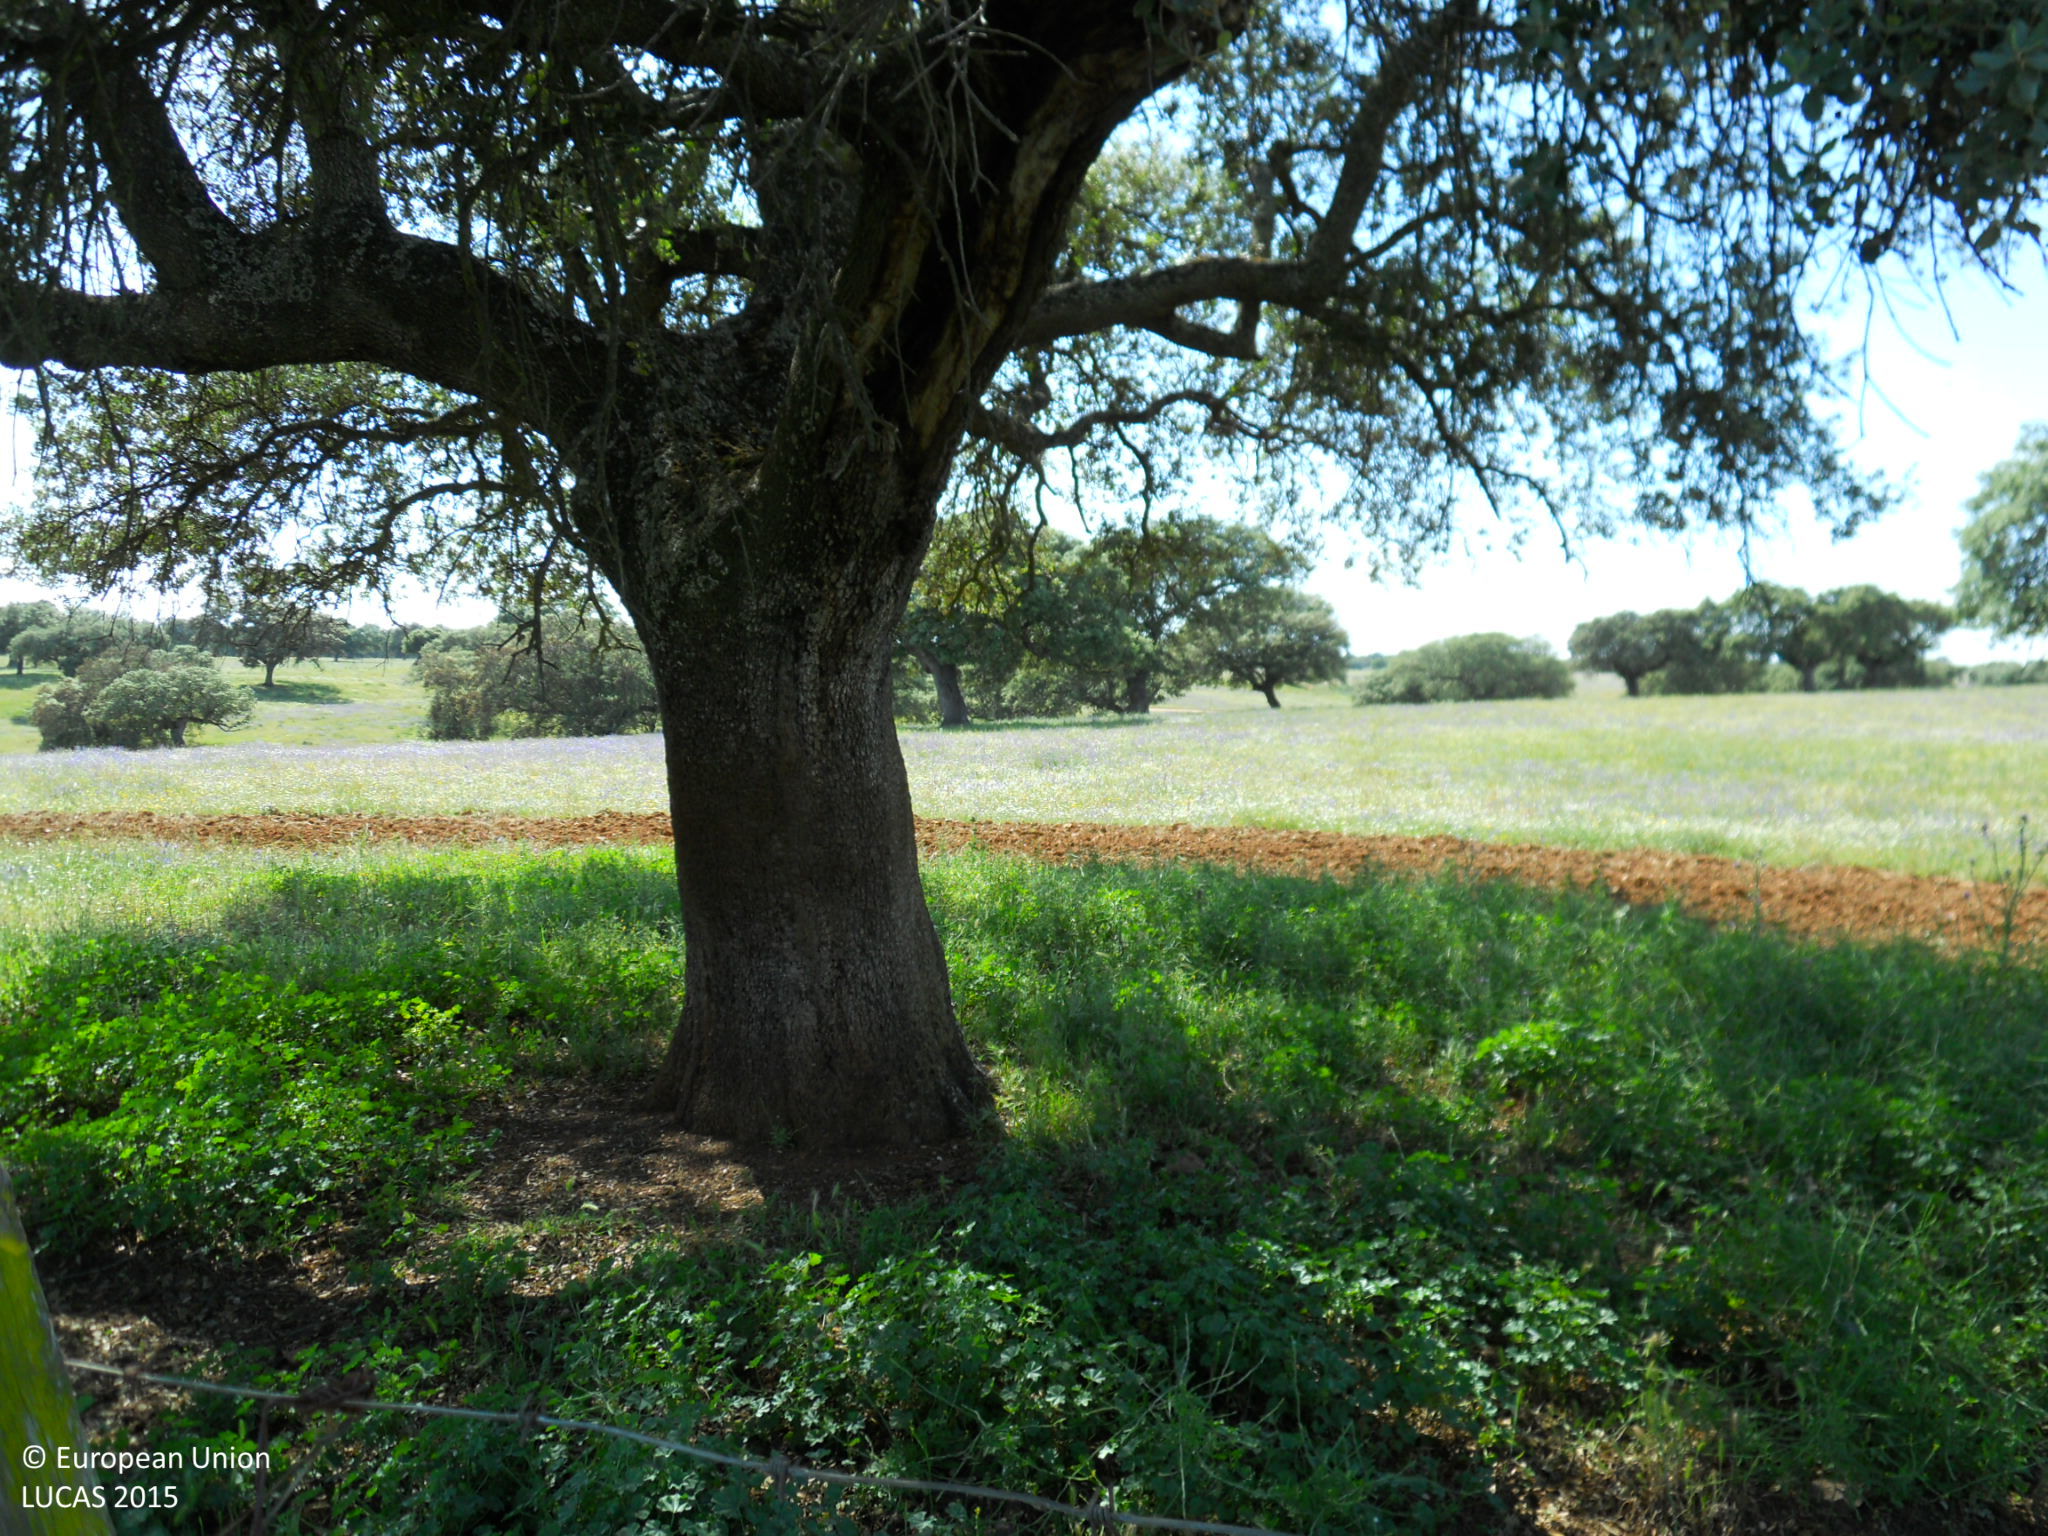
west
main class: Grassland
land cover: Grassland without tree/shrub cover
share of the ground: > 75 %
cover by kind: herbaceous plants 100 %
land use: Agriculture (excluding fallow land and kitchen gardens)
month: April
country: ES
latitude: 39.0031
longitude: -6.9419
